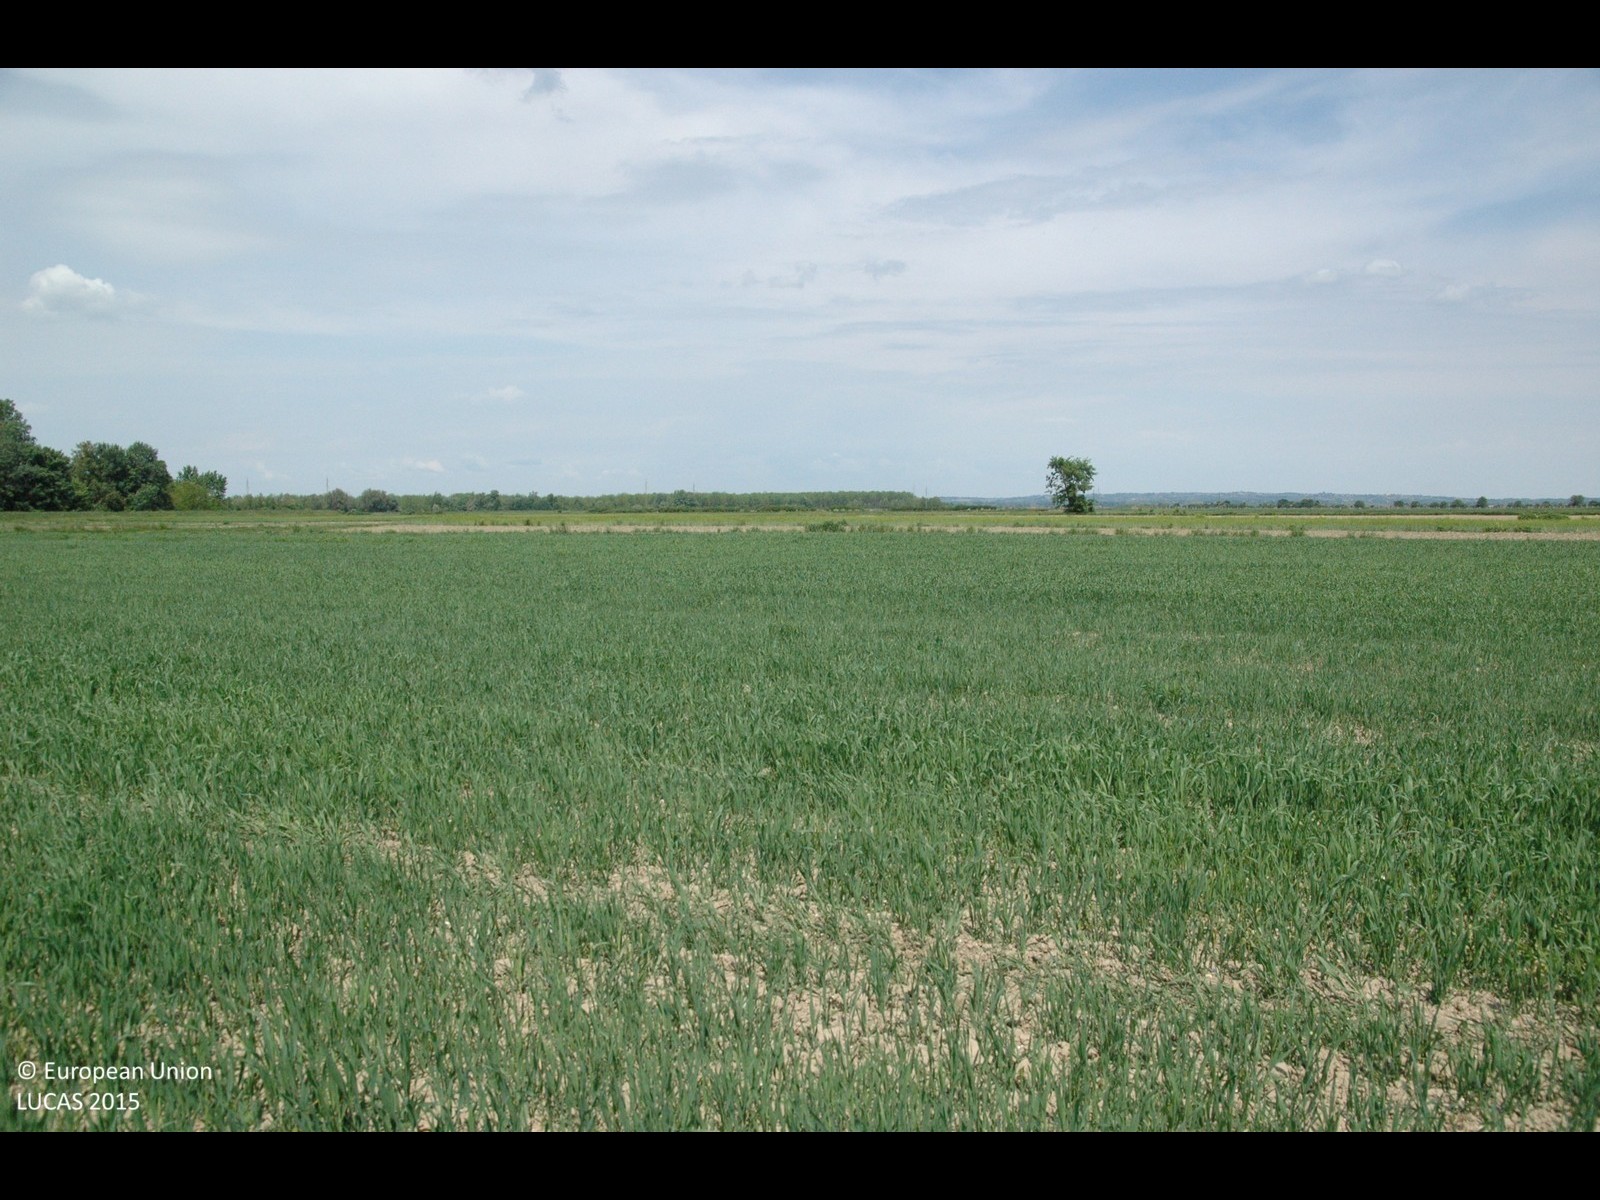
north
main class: Cropland
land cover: Common wheat
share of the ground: > 75 %
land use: Agriculture (excluding fallow land and kitchen gardens)
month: May
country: HR
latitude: 46.3429
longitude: 16.3538
